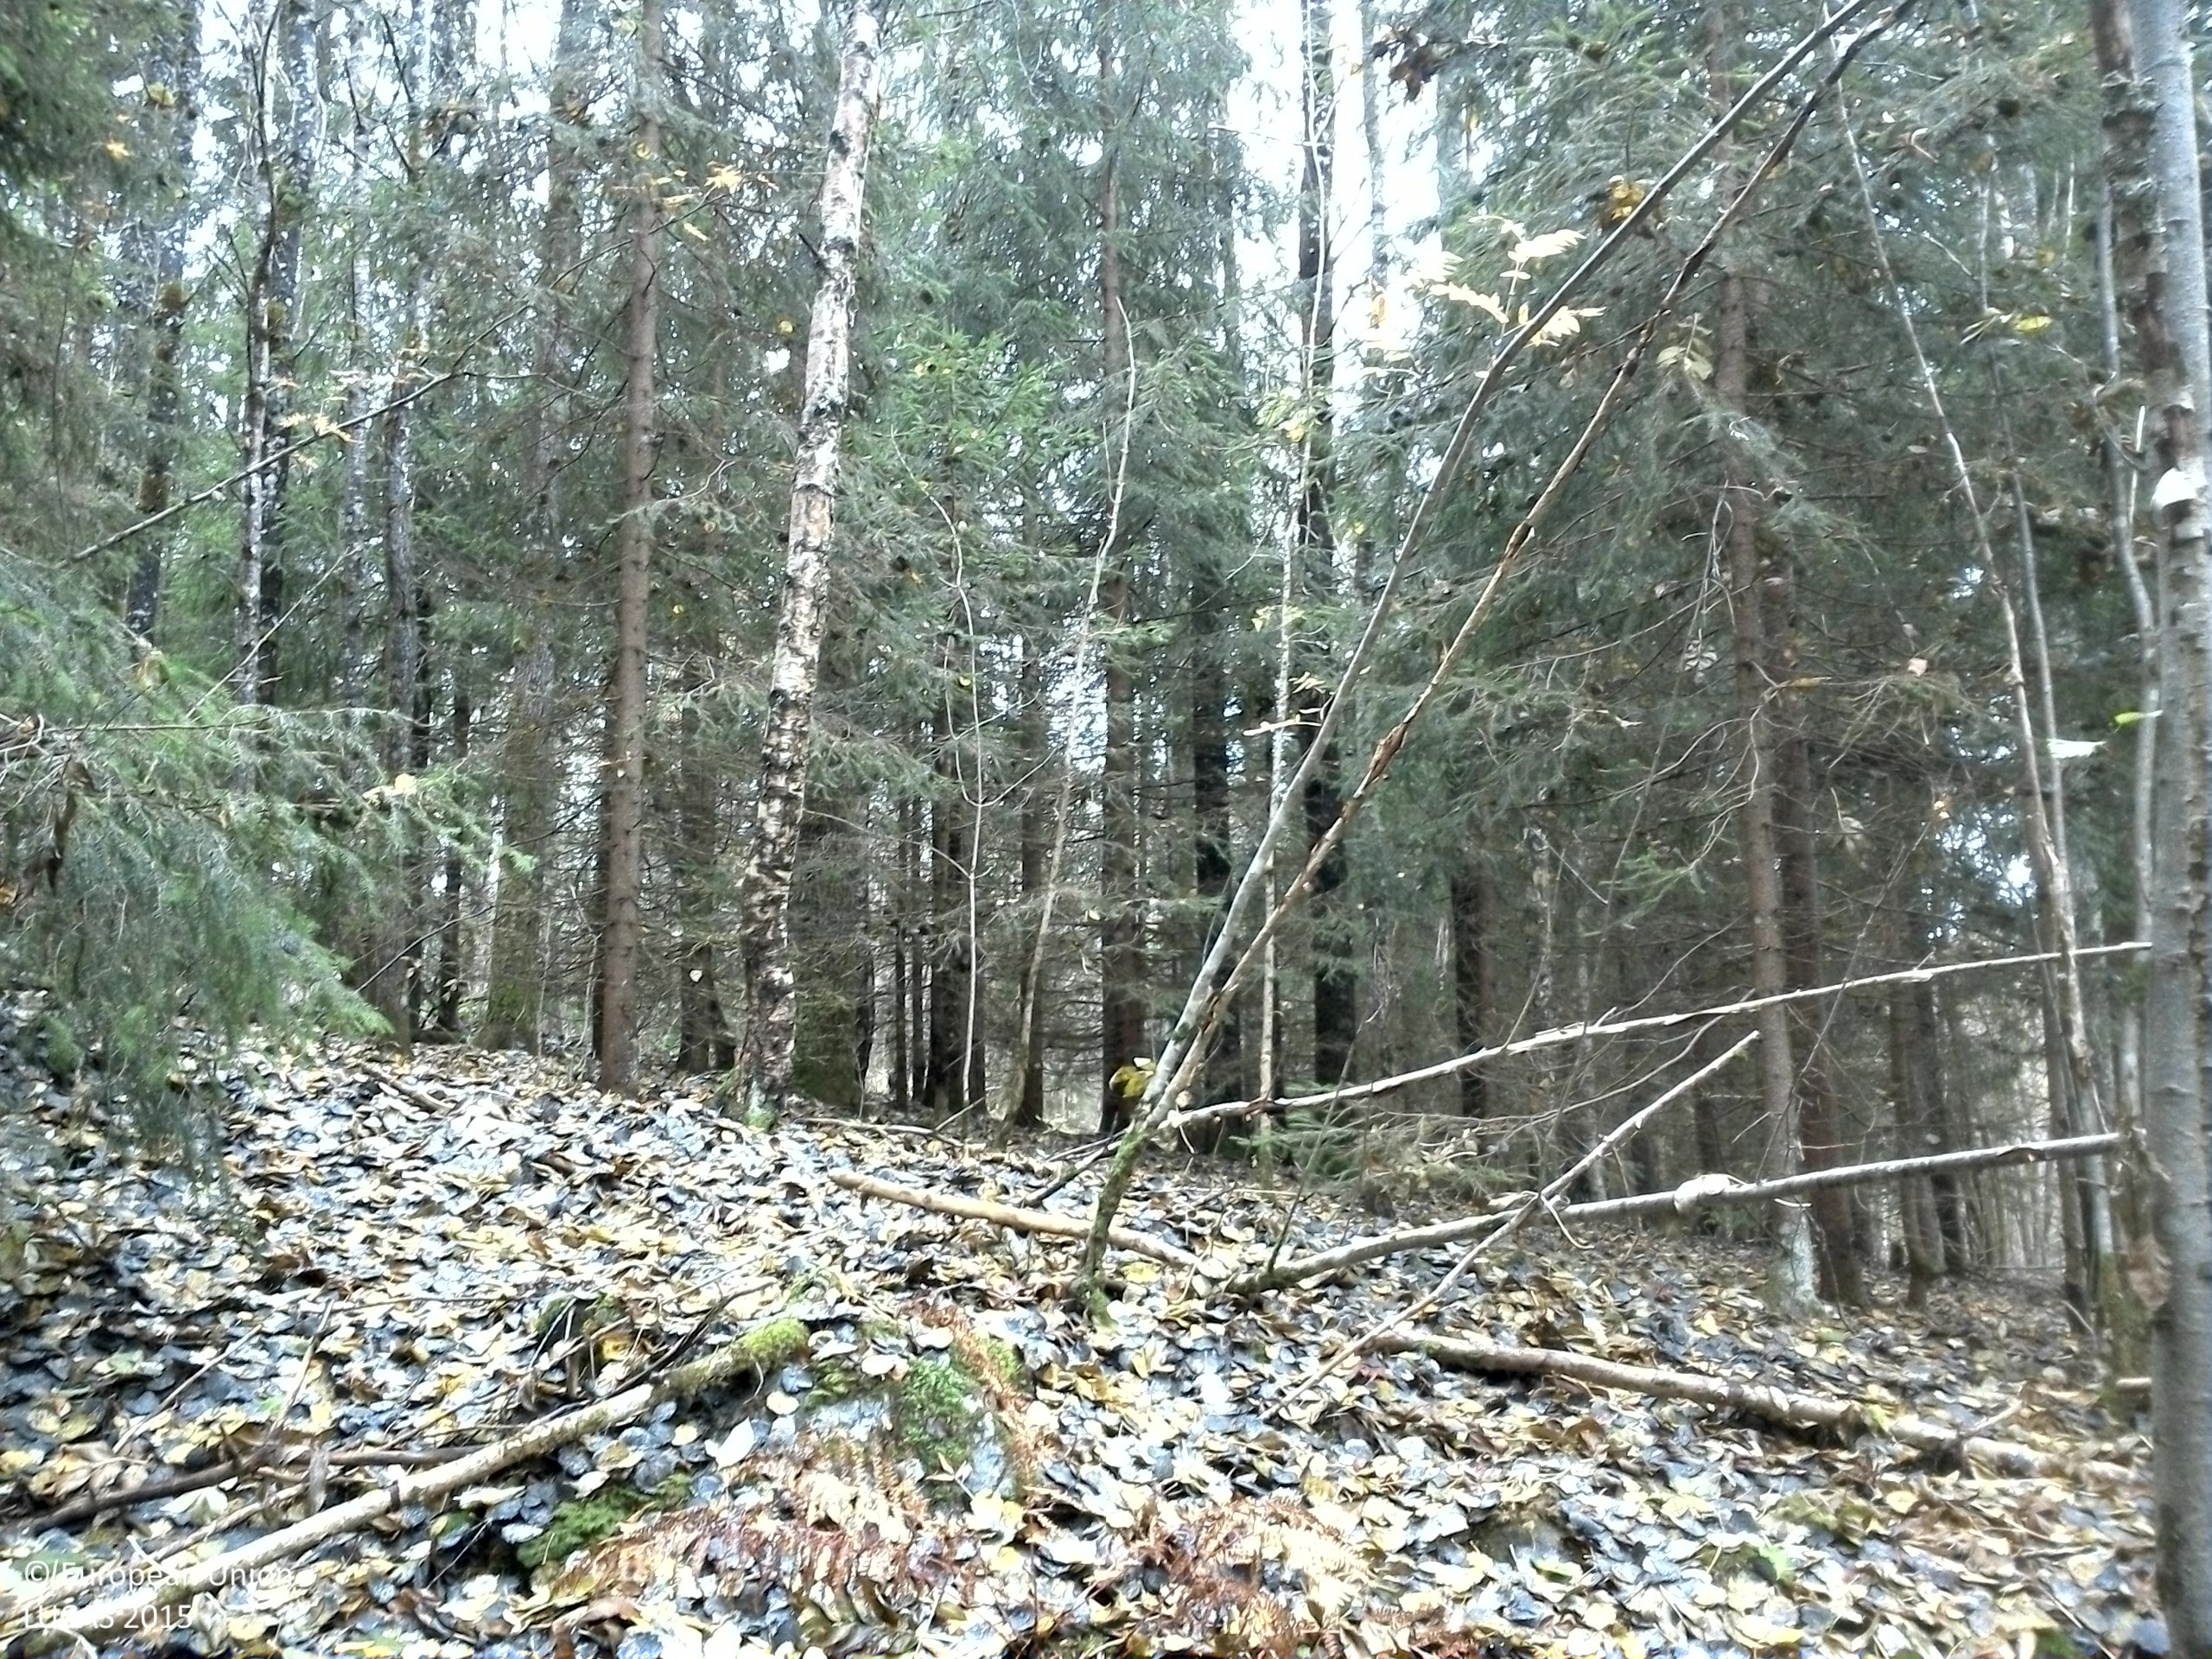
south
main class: Woodland
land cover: Spruce dominated mixed woodland
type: boreal forest
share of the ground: 50 - 75 %
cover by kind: coniferous forest trees 45 %, broadleaved forest trees 20 %, shrubs 15 %, herbaceous plants 10 %, lichens and mosses 10 %
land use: Forestry
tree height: > 5 m
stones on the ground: 10 - 25 %
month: October
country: SE
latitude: 59.7240
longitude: 15.2005
